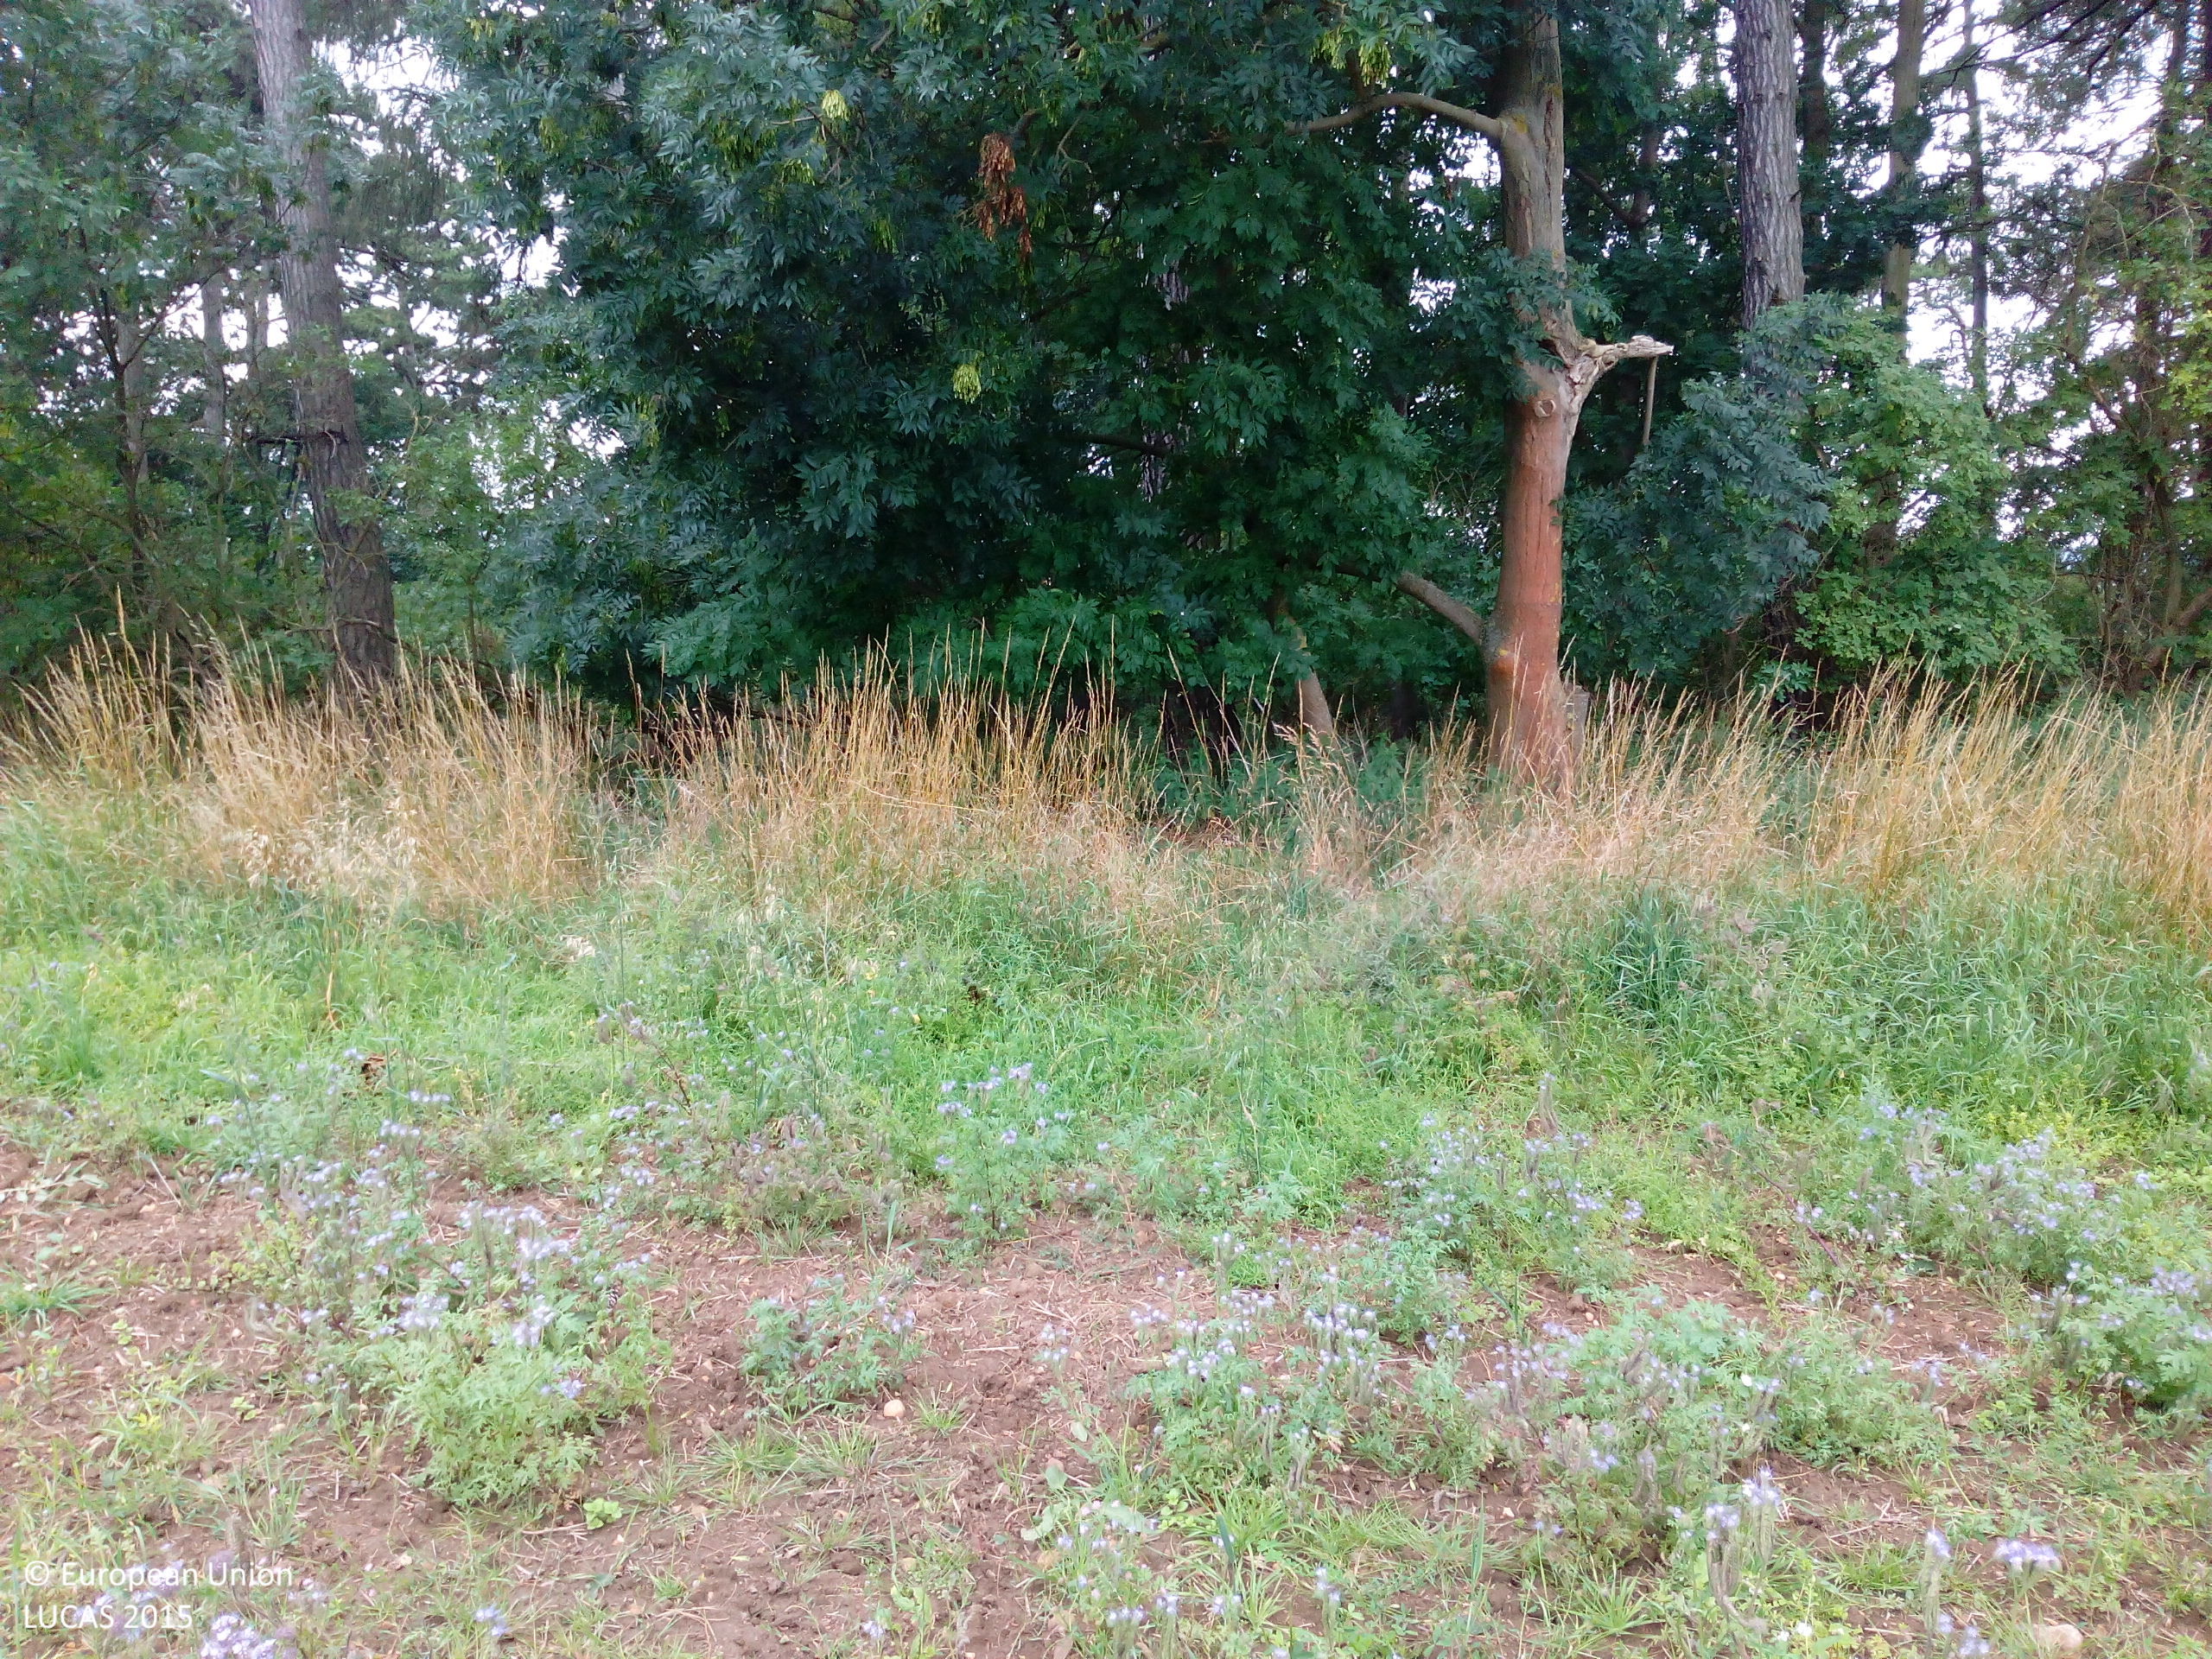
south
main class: Cropland
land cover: Other leguminous and mixtures for fodder
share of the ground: > 75 %
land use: Agriculture (excluding fallow land and kitchen gardens)
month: July
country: DE
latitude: 52.1957
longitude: 10.6874
